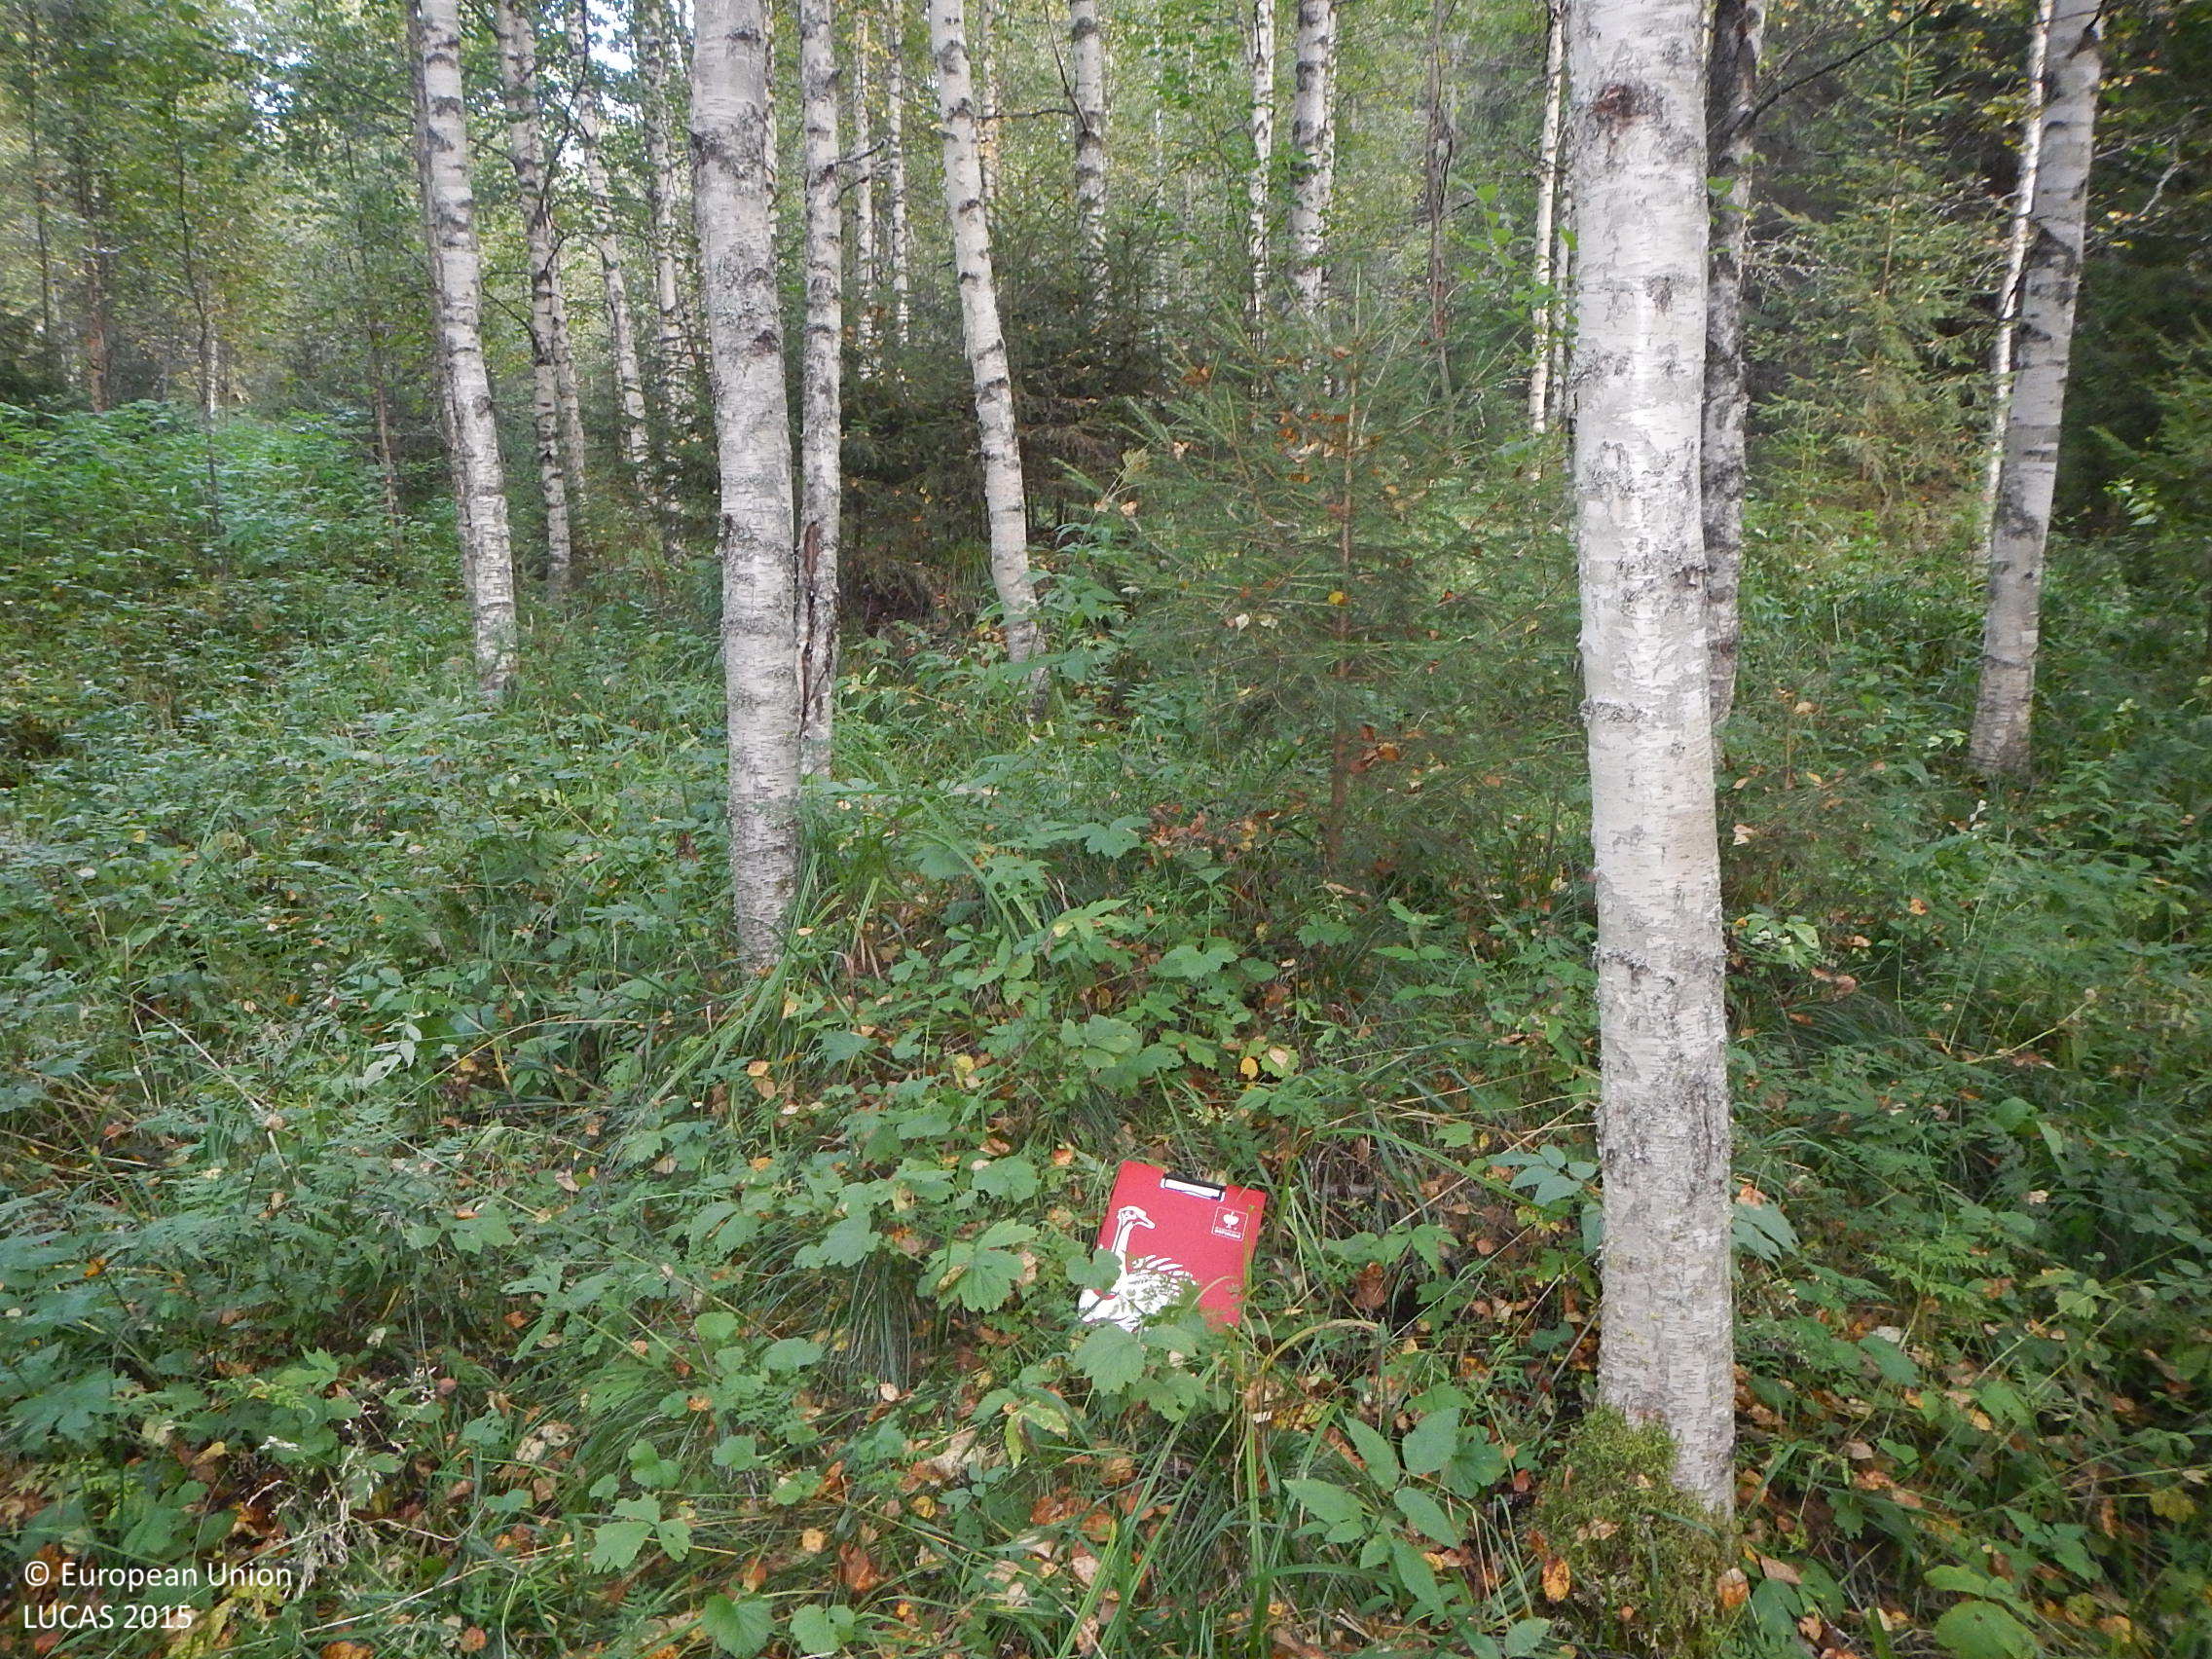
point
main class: Woodland
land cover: Broadleaved woodland
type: non-riverine alder, birch or aspen forest
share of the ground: > 75 %
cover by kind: broadleaved forest trees 75 %, herbaceous plants 20 %, shrubs 5 %
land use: Forestry
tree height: > 5 m
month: September
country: FI
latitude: 61.4657
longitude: 22.0870
